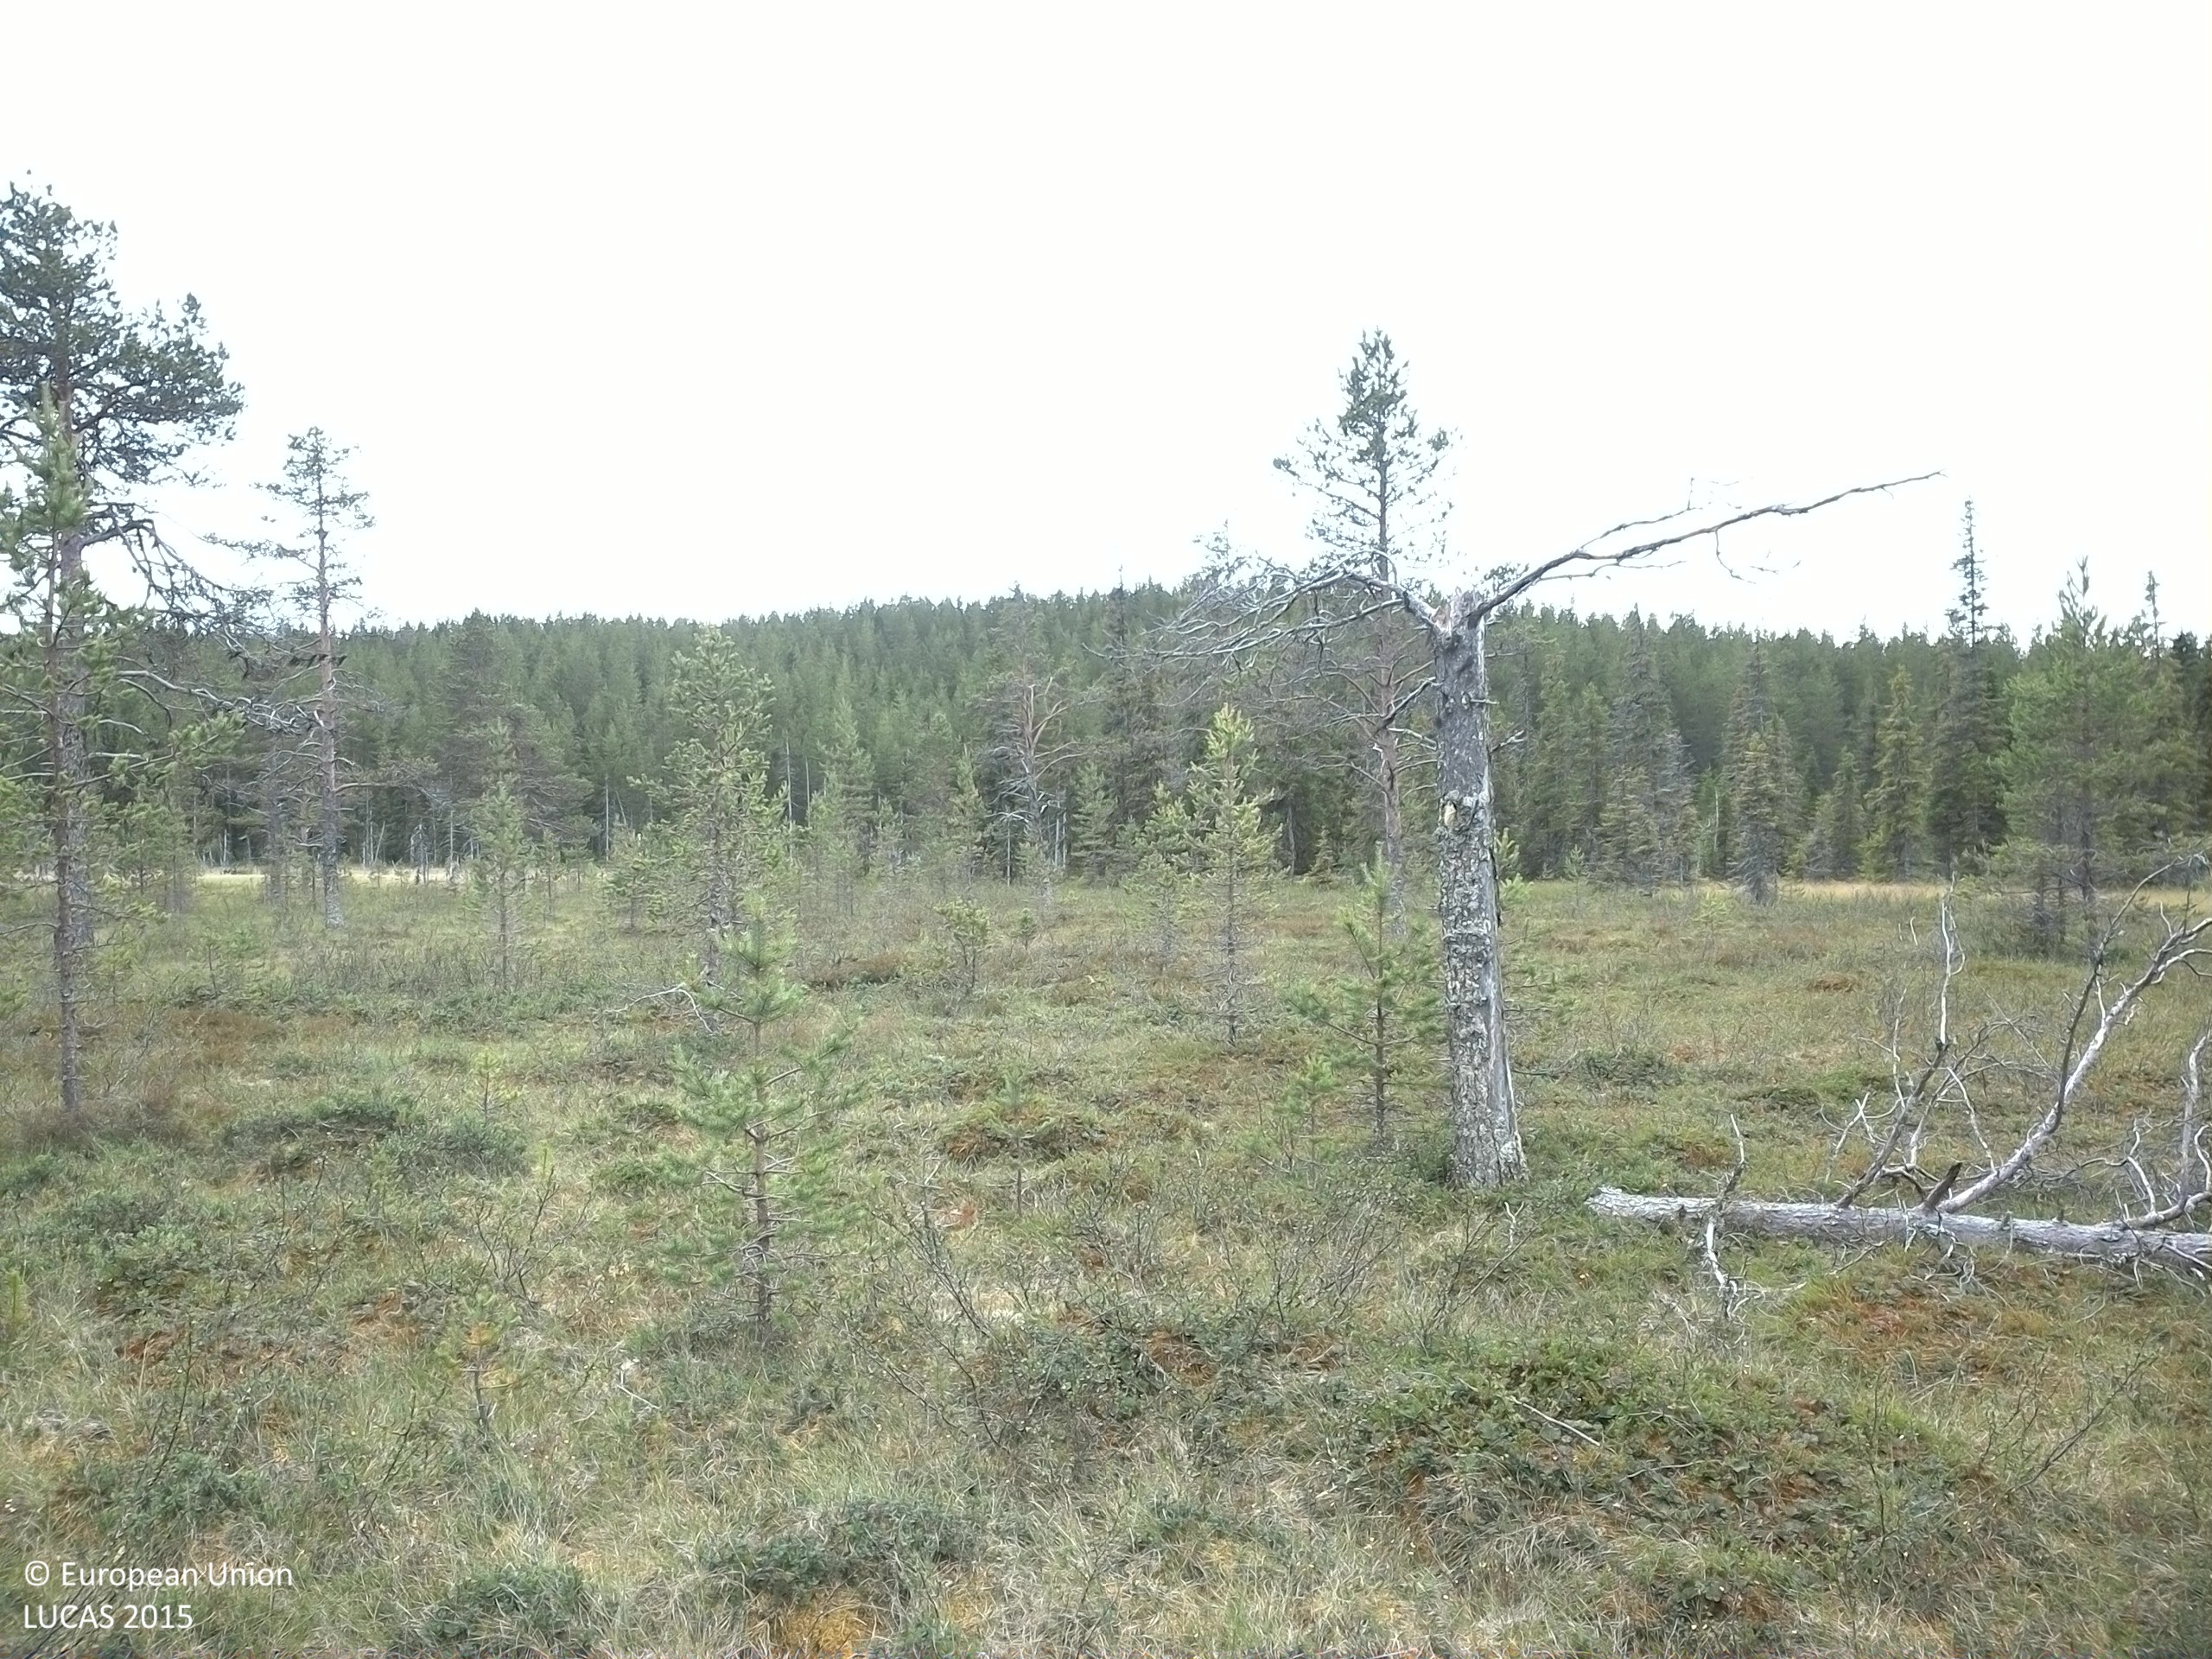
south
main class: Woodland
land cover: Pine dominated coniferous woodland
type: boreal forest
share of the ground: 10 - 25 %
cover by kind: lichens and mosses 40 %, shrubs 35 %, coniferous forest trees 15 %, herbaceous plants 10 %
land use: Forestry
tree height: < 5 m
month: August
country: SE
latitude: 62.8752
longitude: 17.1927
